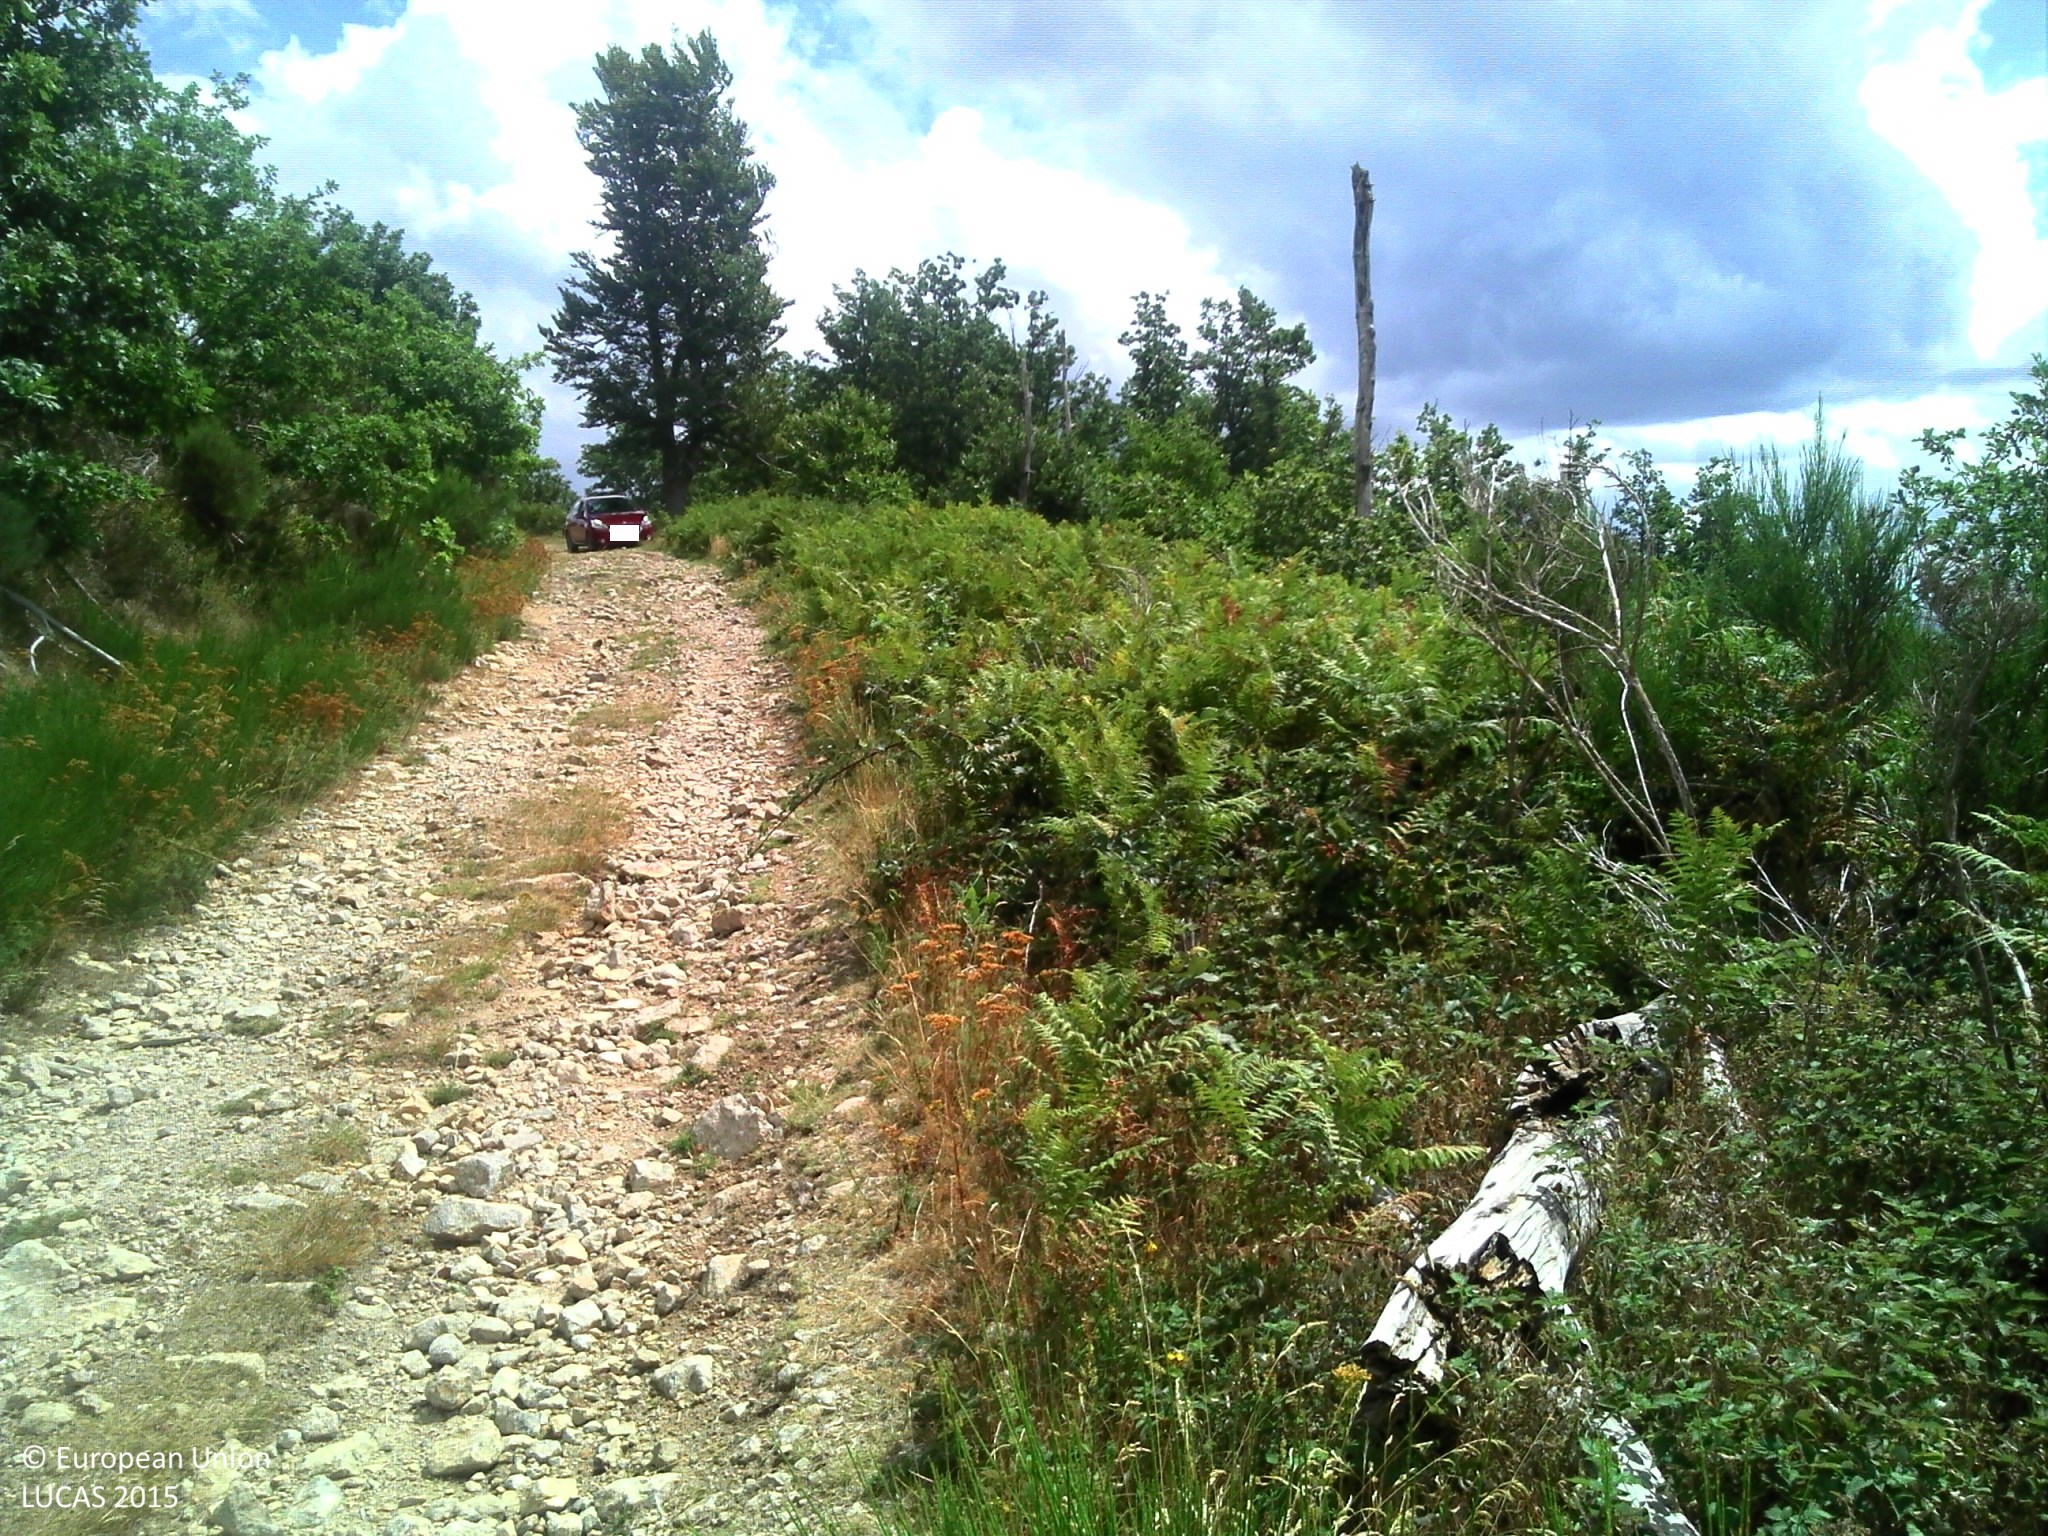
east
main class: Shrubland
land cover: Shrubland with sparse tree cover
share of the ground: > 75 %
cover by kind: shrubs 95 %, broadleaved forest trees 5 %
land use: Semi-natural and natural areas not in use
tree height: < 5 m
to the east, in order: Shrubland with sparse tree cover; Broadleaved woodland; Rock outcrops; Shrubland with sparse tree cover
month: August
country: FR
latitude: 45.0929
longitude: 4.5539
